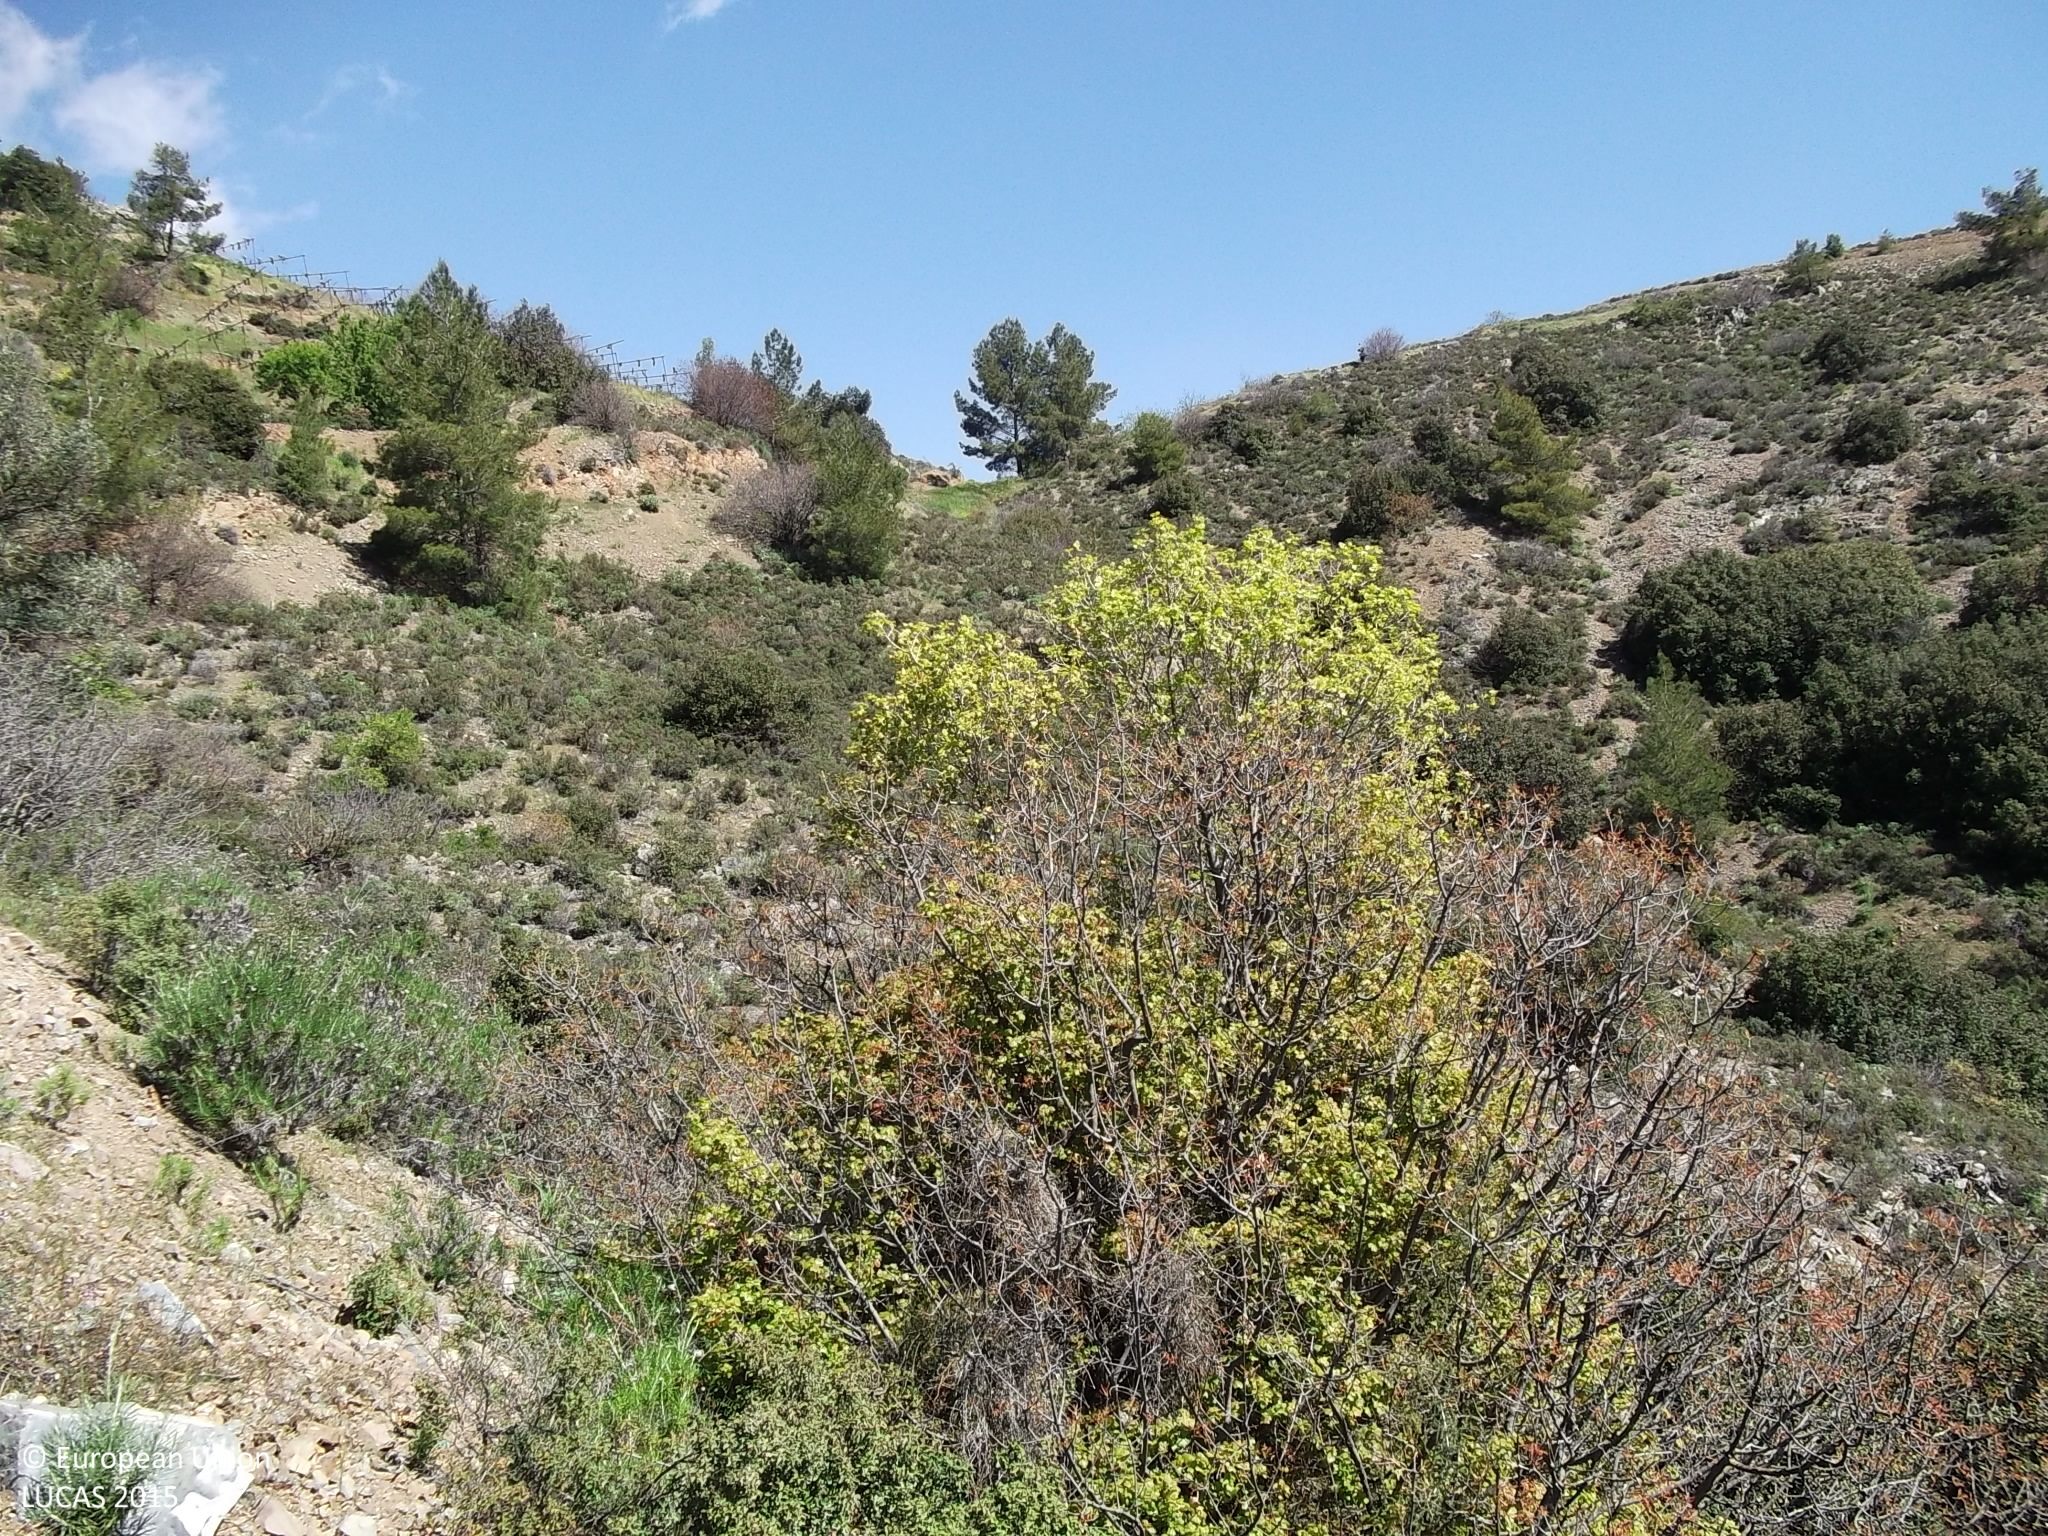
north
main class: Woodland
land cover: Broadleaved woodland
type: broadleaved evergreen forest
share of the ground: 25 - 50 %
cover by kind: broadleaved forest trees 45 %, shrubs 25 %, herbaceous plants 10 %, consolidated bare surface 10 %, unconsolidated bare surface 10 %
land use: Semi-natural and natural areas not in use
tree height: > 5 m
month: April
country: CY
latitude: 34.8994
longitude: 33.1008
